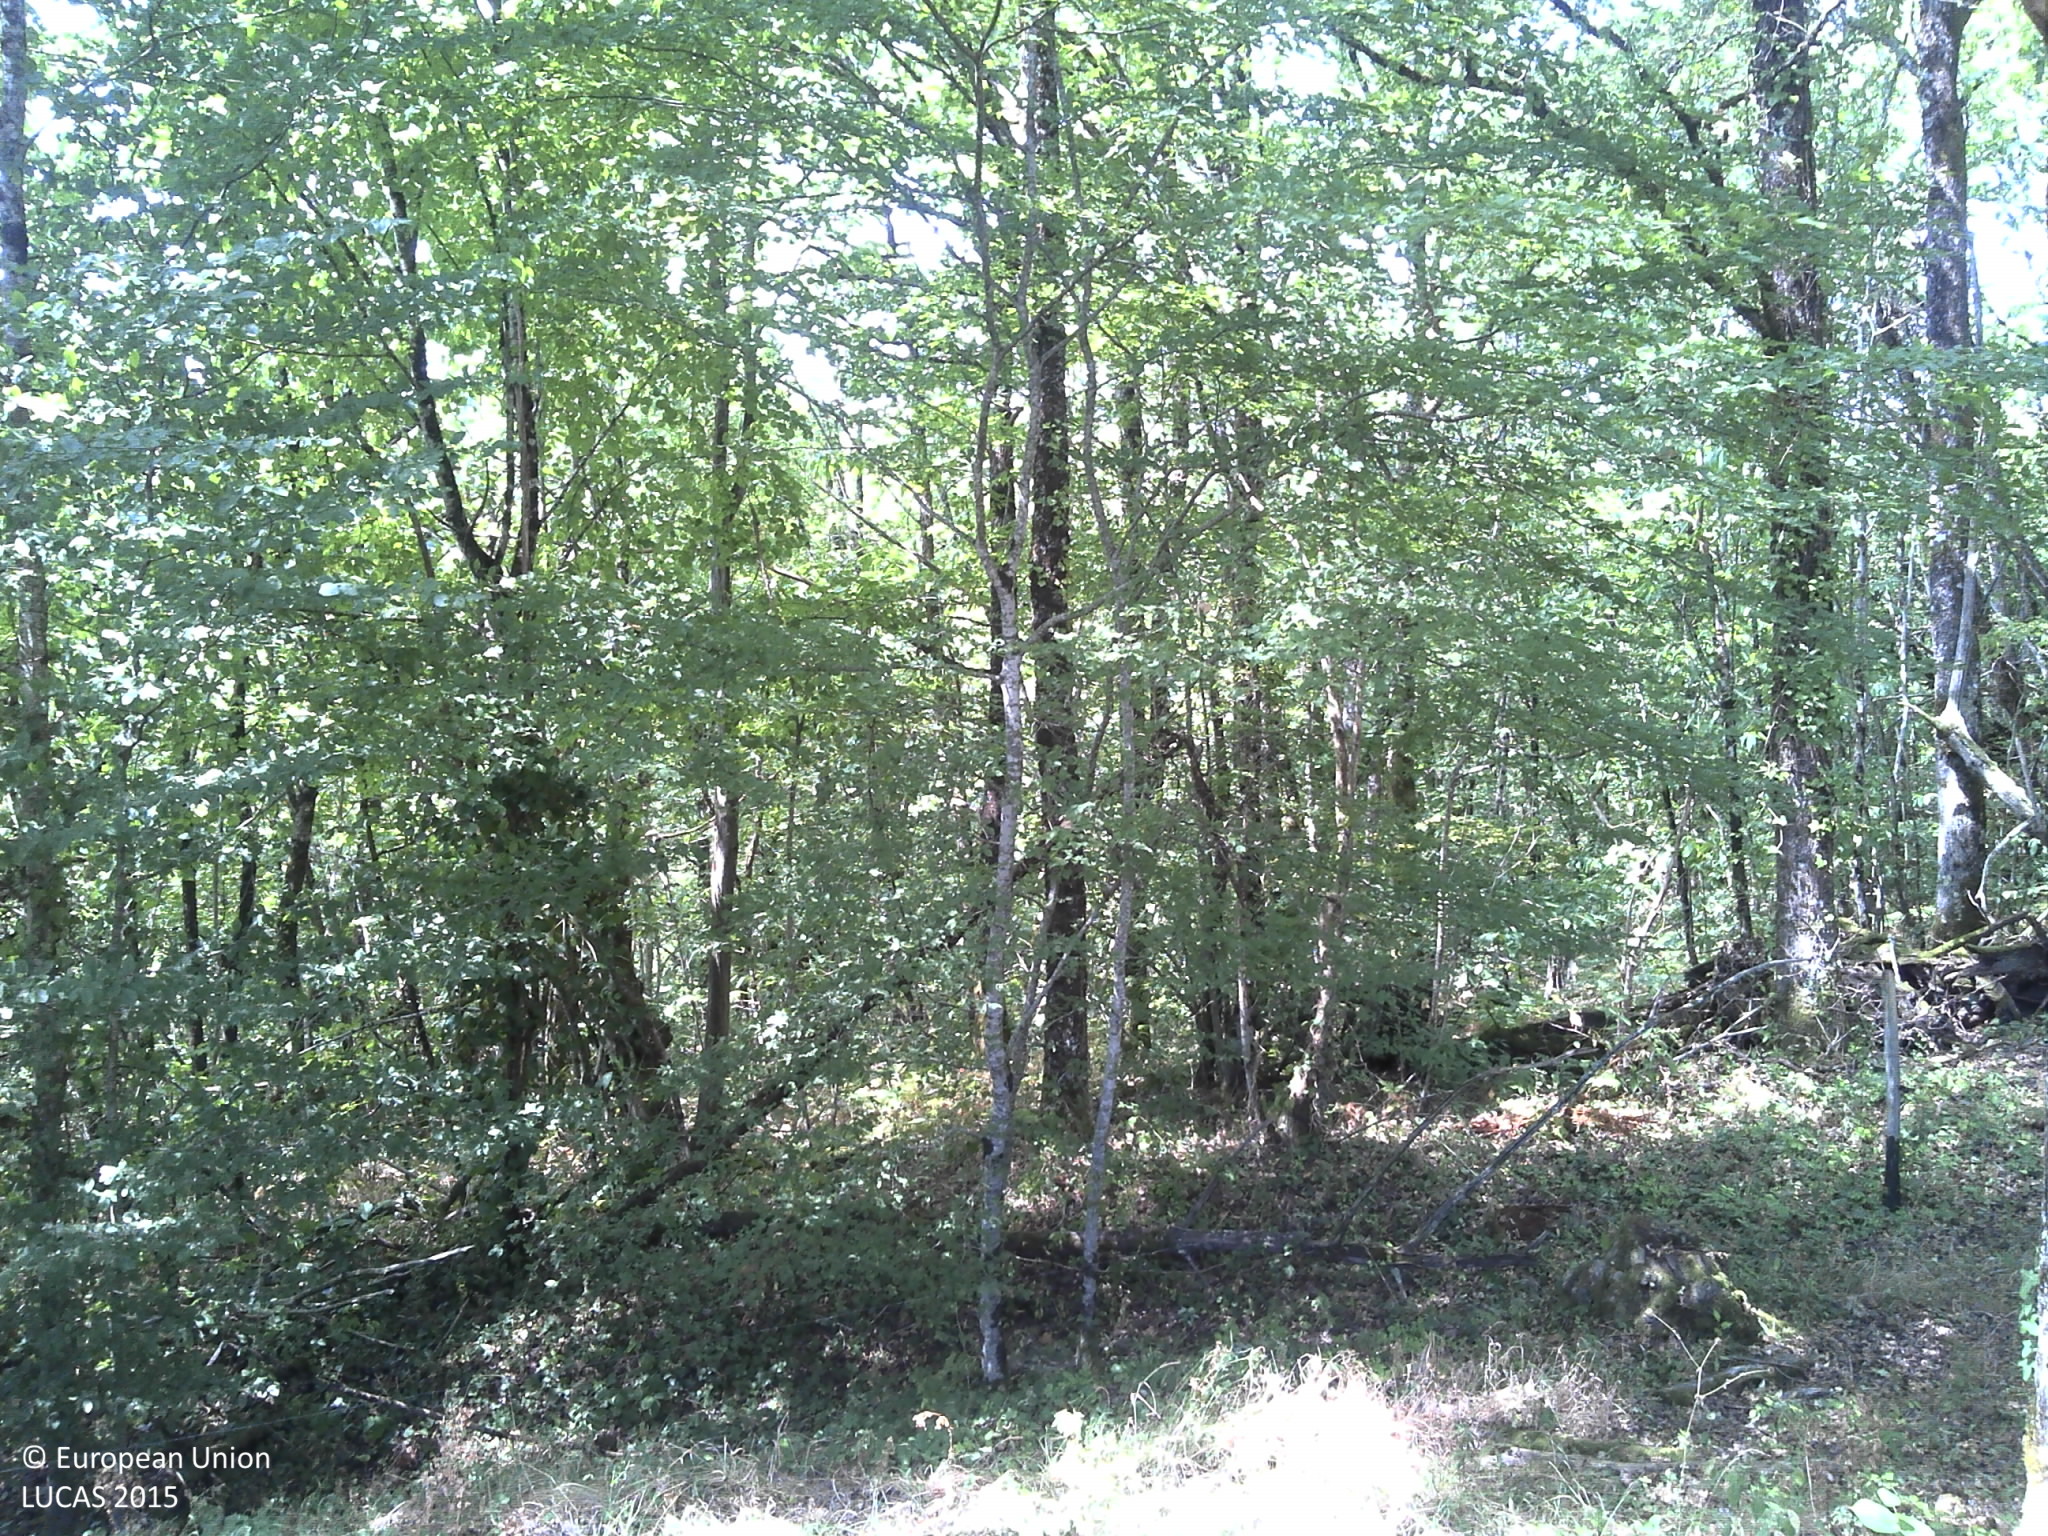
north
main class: Woodland
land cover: Broadleaved woodland
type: thermophilous deciduous forest
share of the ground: > 75 %
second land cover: Grassland without tree/shrub cover
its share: > 75 %
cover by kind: broadleaved forest trees 50 %, herbaceous plants 45 %, lichens and mosses 5 %
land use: Forestry
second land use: Agriculture (excluding fallow land and kitchen gardens)
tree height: > 5 m
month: July
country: FR
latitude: 45.0727
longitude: 1.7533
